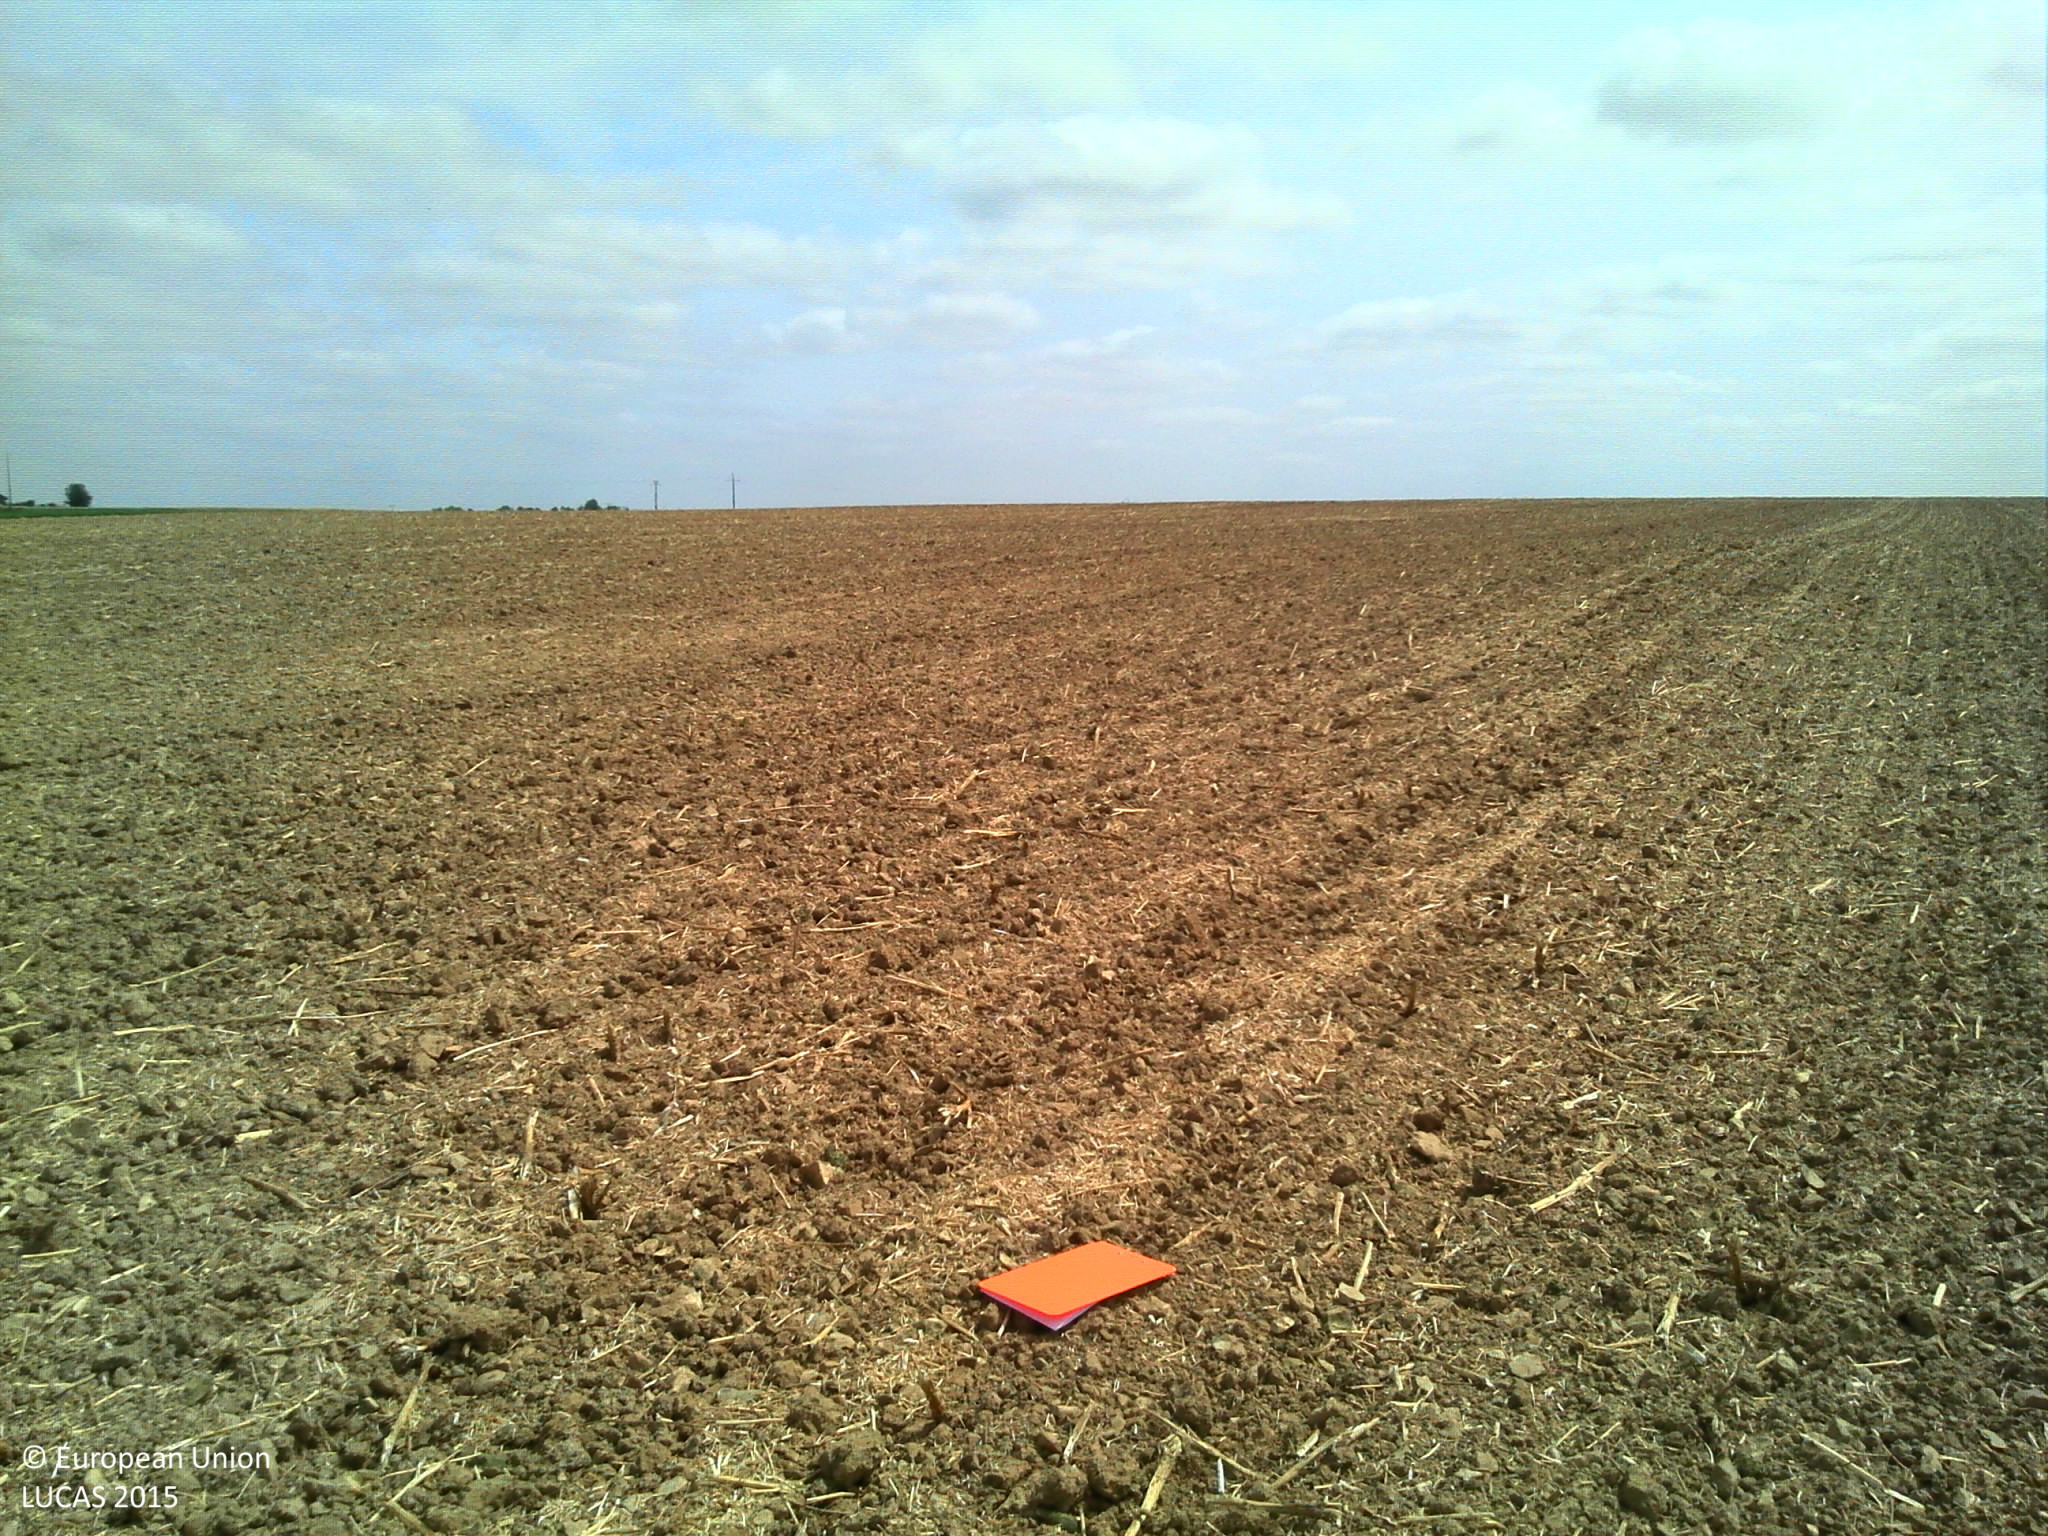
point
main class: Cropland
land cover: Rape and turnip rape
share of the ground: < 10 %
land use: Agriculture (excluding fallow land and kitchen gardens)
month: July
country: FR
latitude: 46.6230
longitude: 0.1714
